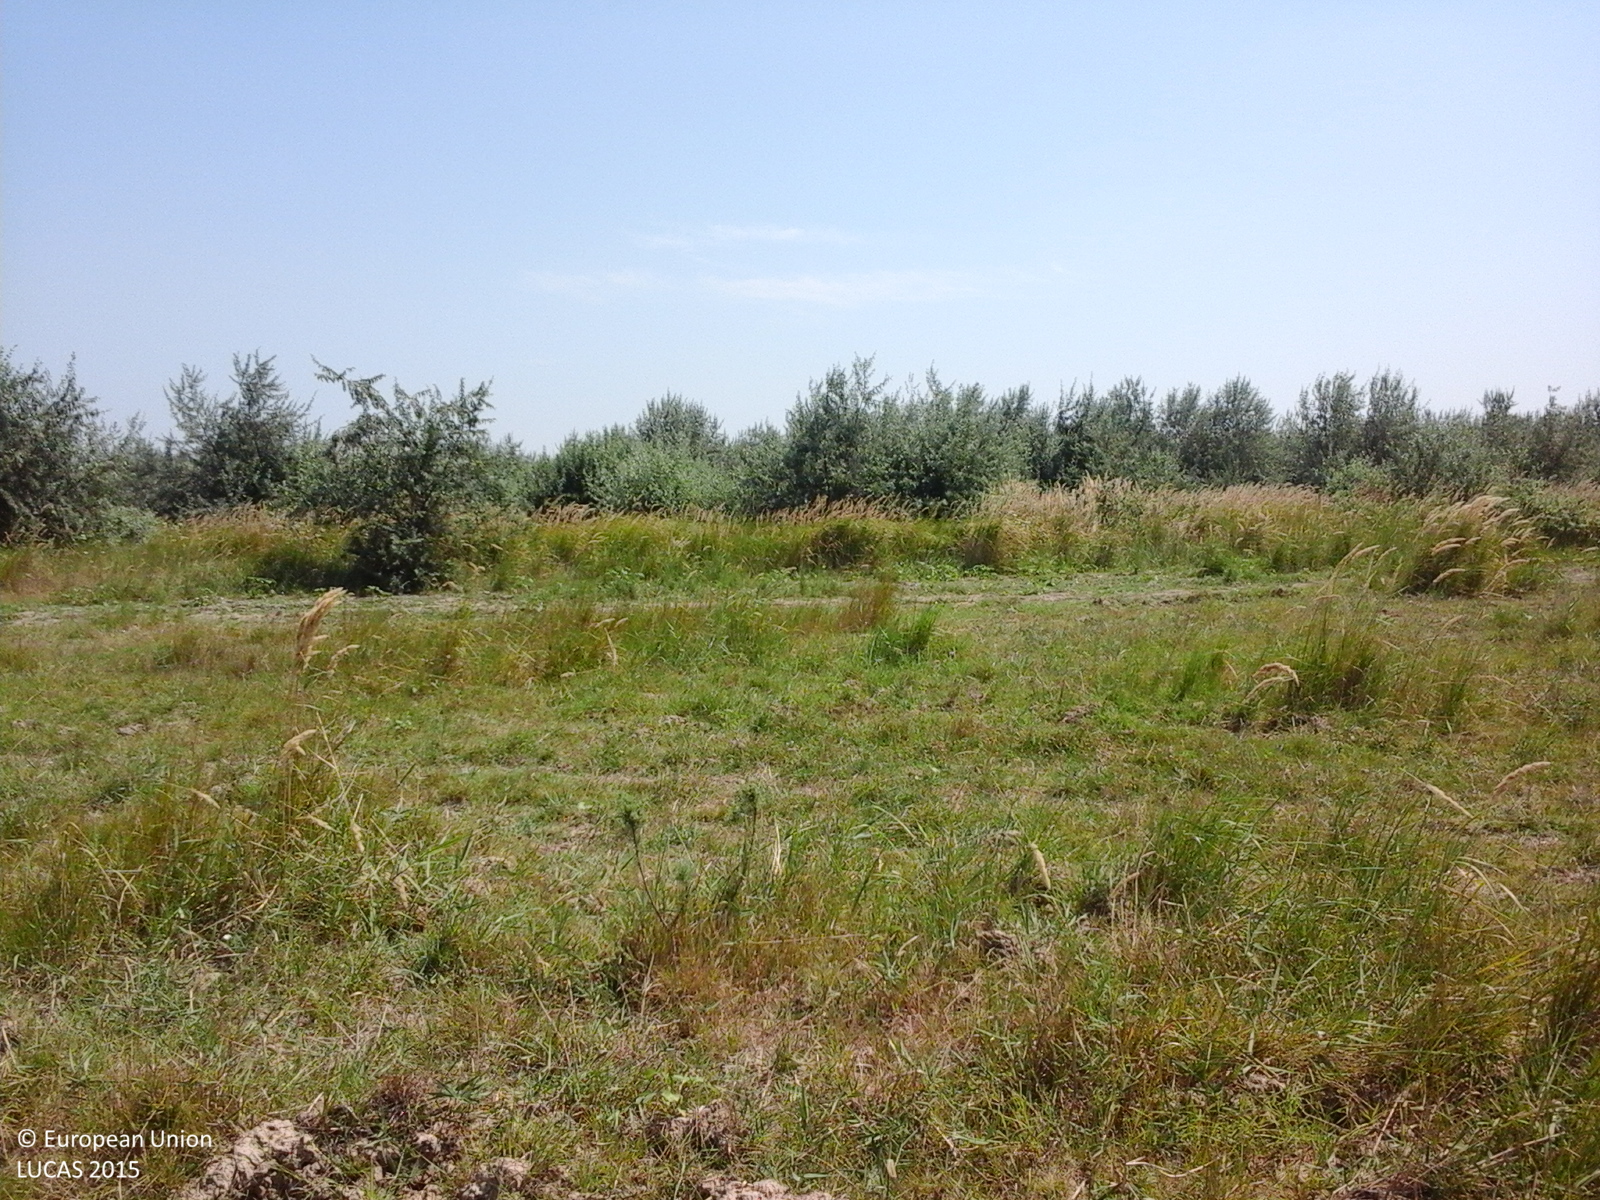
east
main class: Grassland
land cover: Spontaneously vegetated surfaces
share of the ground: > 75 %
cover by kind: herbaceous plants 100 %
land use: Agriculture (excluding fallow land and kitchen gardens)
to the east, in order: Spontaneously vegetated surfaces; Tracks; Spontaneously vegetated surfaces; Tracks; Spontaneously vegetated surfaces; Shrubland with sparse tree cover
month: August
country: RO
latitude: 45.2098
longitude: 27.3738
